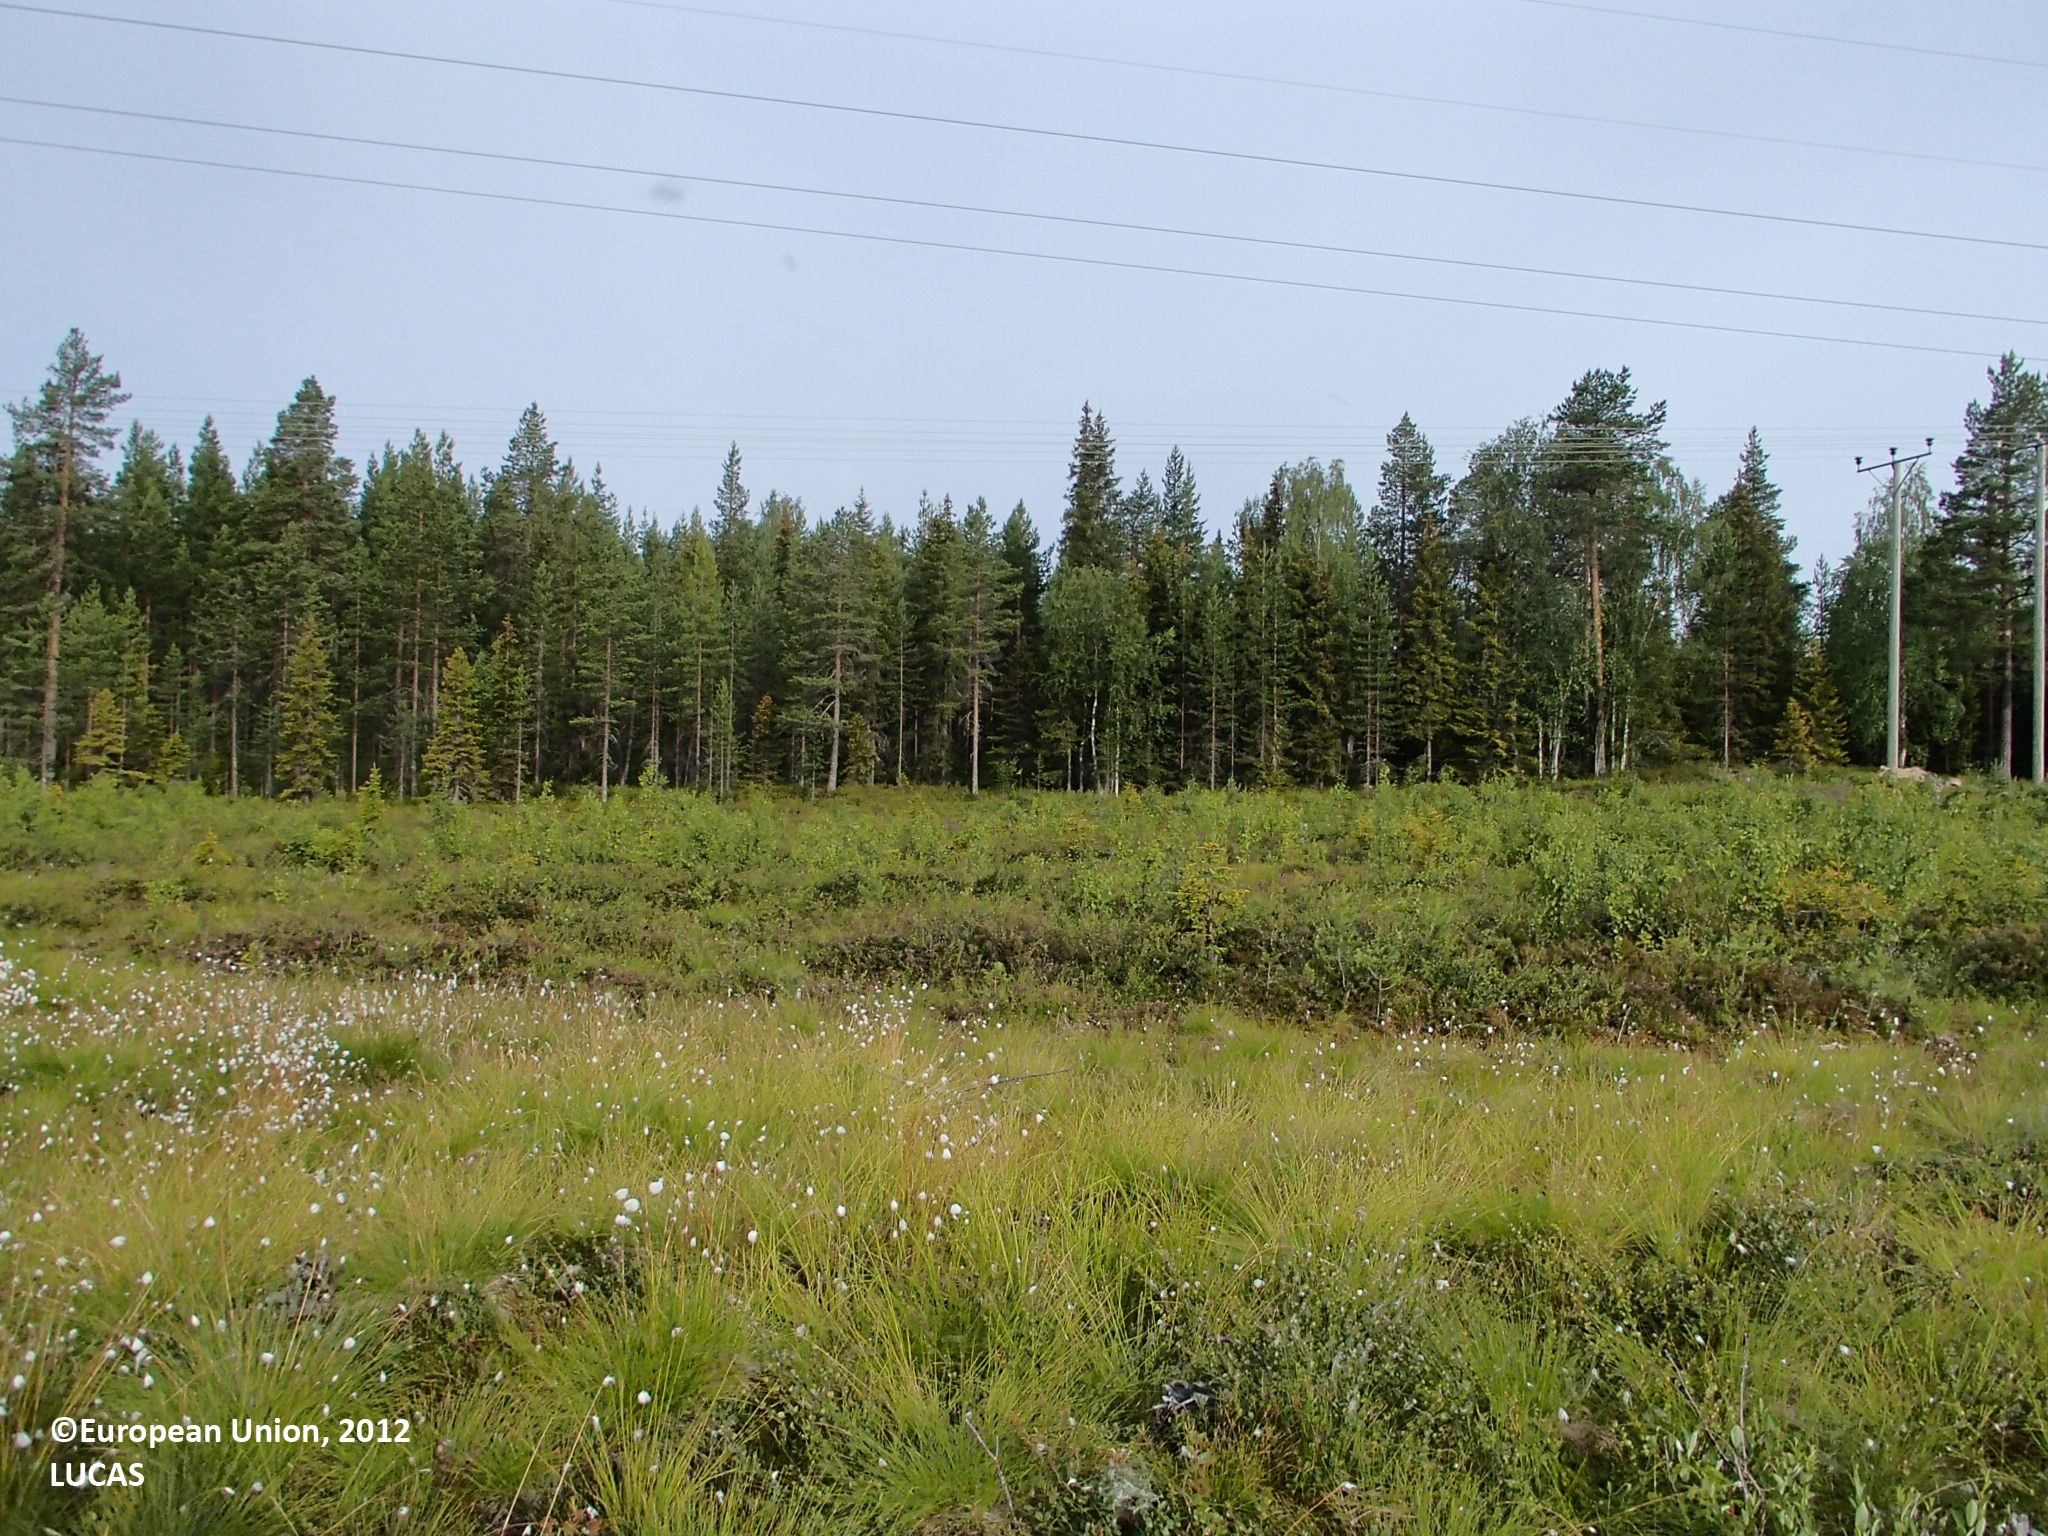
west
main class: Grassland
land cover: Grassland with sparse tree/shrub cover
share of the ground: > 75 %
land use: Energy production
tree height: < 5 m
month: July
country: FI
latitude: 66.4382
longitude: 25.5571
